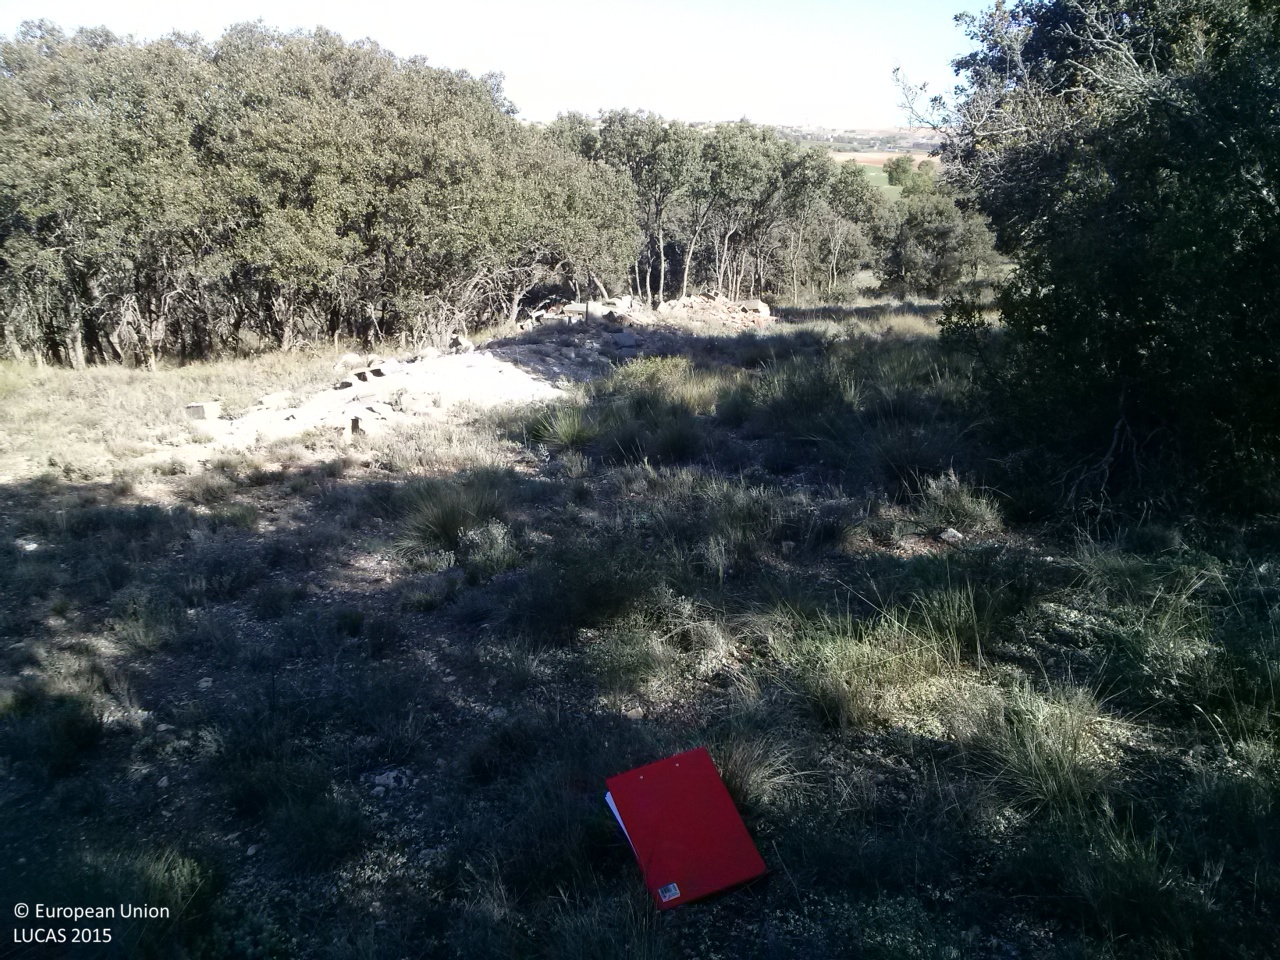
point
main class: Woodland
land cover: Broadleaved woodland
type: broadleaved evergreen forest
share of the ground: 25 - 50 %
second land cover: Grassland without tree/shrub cover
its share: 25 - 50 %
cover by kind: broadleaved forest trees 45 %, herbaceous plants 30 %, unconsolidated bare surface 20 %, shrubs 5 %
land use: Forestry
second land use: Agriculture (excluding fallow land and kitchen gardens)
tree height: < 5 m
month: May
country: ES
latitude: 39.9033
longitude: -2.7812
